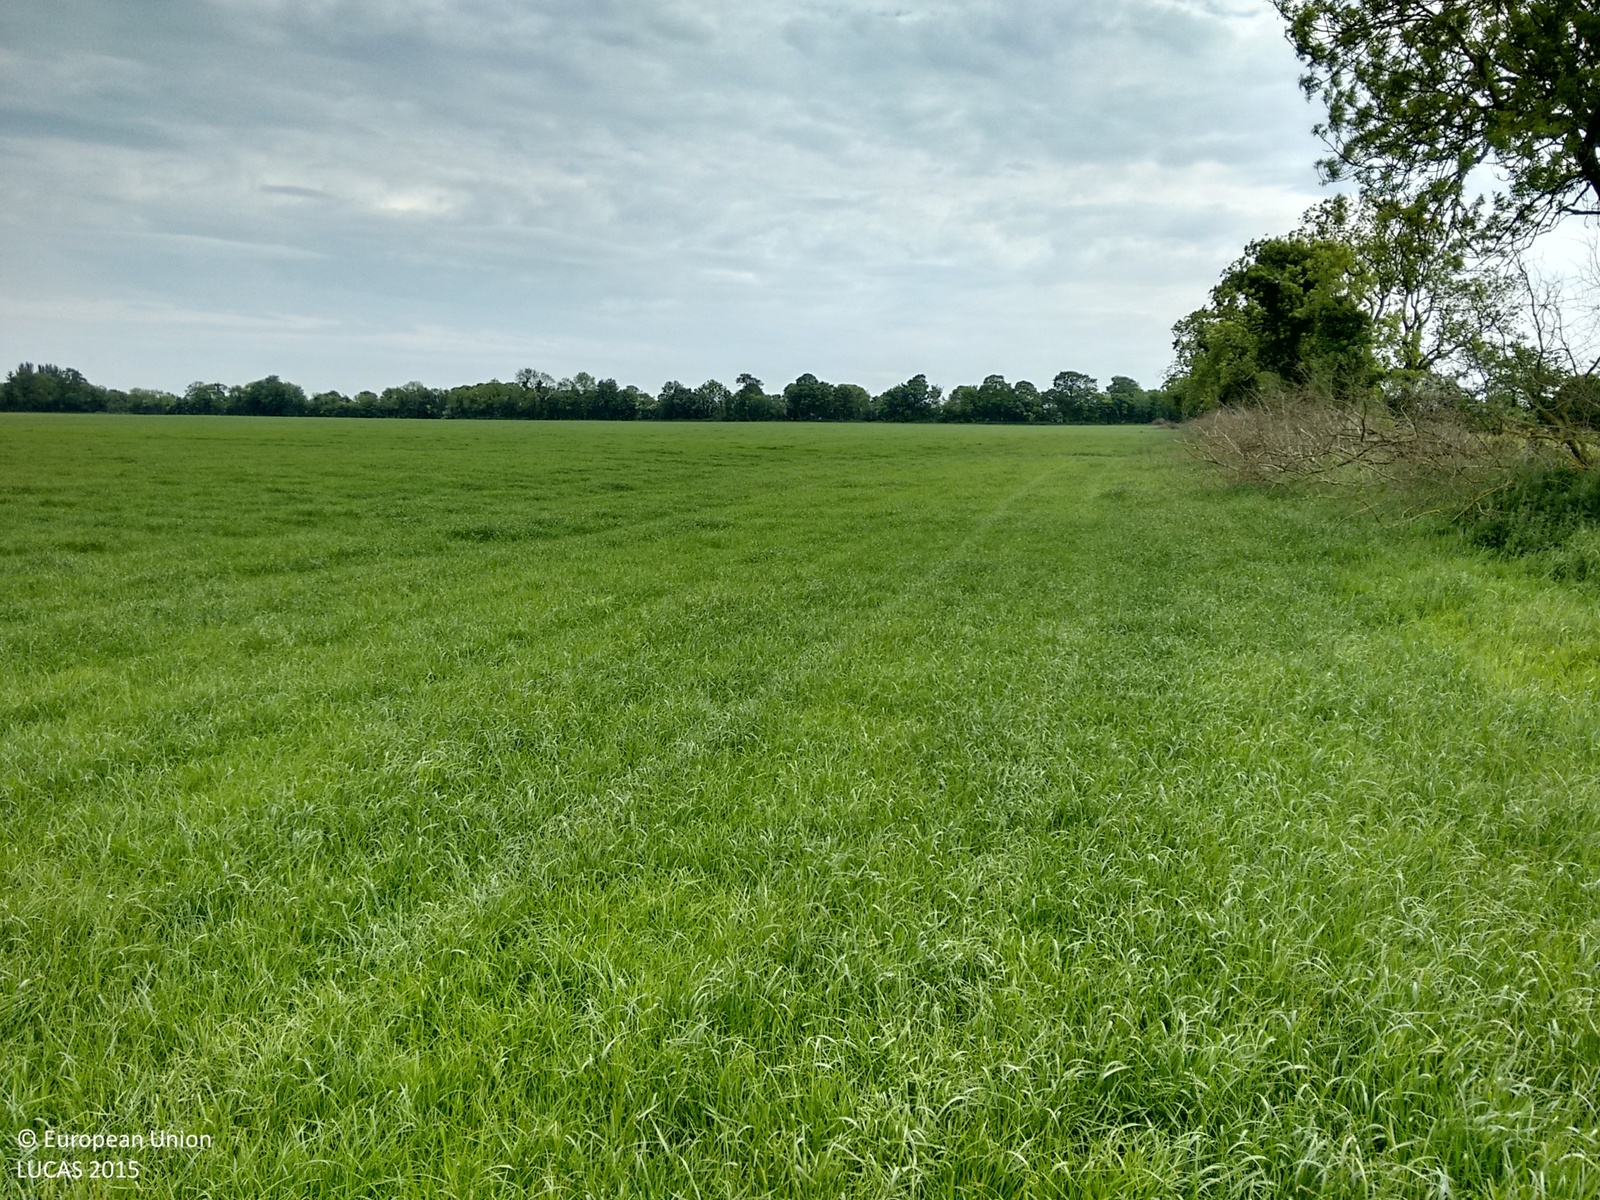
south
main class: Grassland
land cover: Grassland without tree/shrub cover
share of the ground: > 75 %
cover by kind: herbaceous plants 95 %, unconsolidated bare surface 5 %
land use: Agriculture (excluding fallow land and kitchen gardens)
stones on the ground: < 10 %
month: June
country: IE
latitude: 53.5583
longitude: -6.5372
